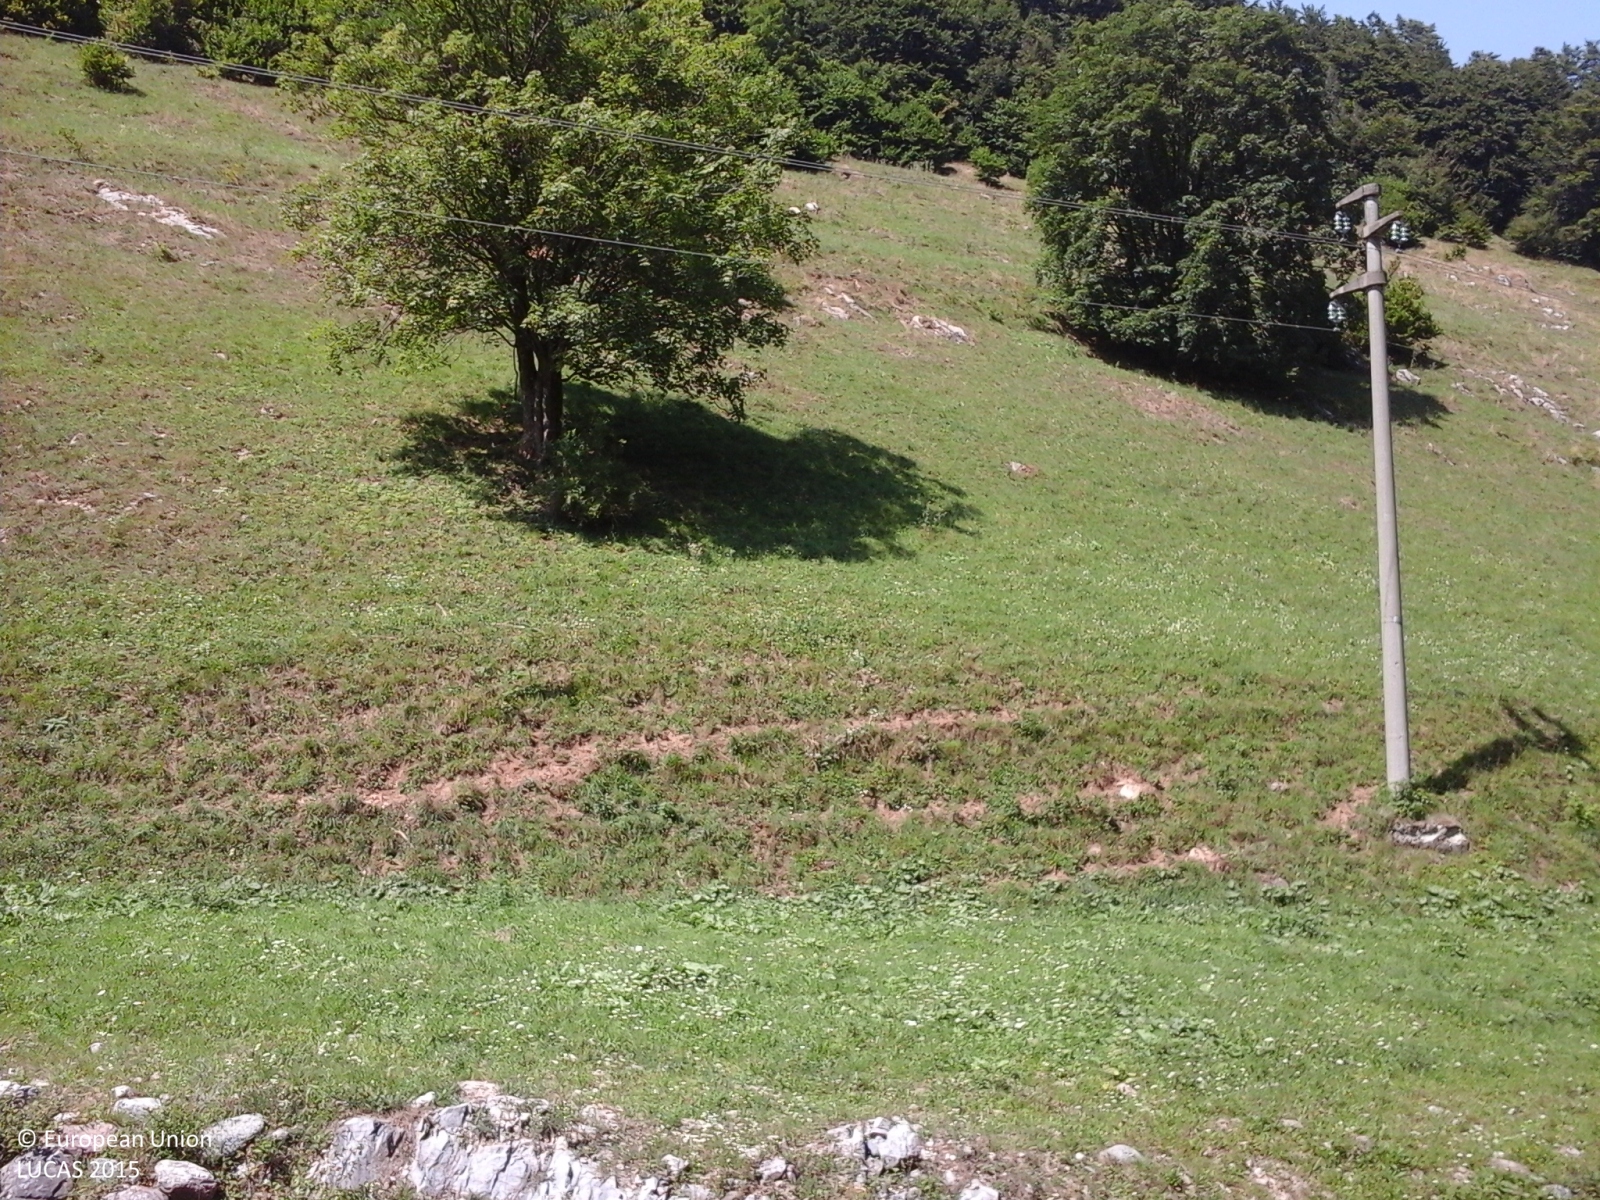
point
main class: Grassland
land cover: Grassland with sparse tree/shrub cover
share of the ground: > 75 %
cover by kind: herbaceous plants 95 %, broadleaved forest trees 5 %
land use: Agriculture (excluding fallow land and kitchen gardens)
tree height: > 5 m
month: August
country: IT
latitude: 44.2543
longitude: 7.7631
